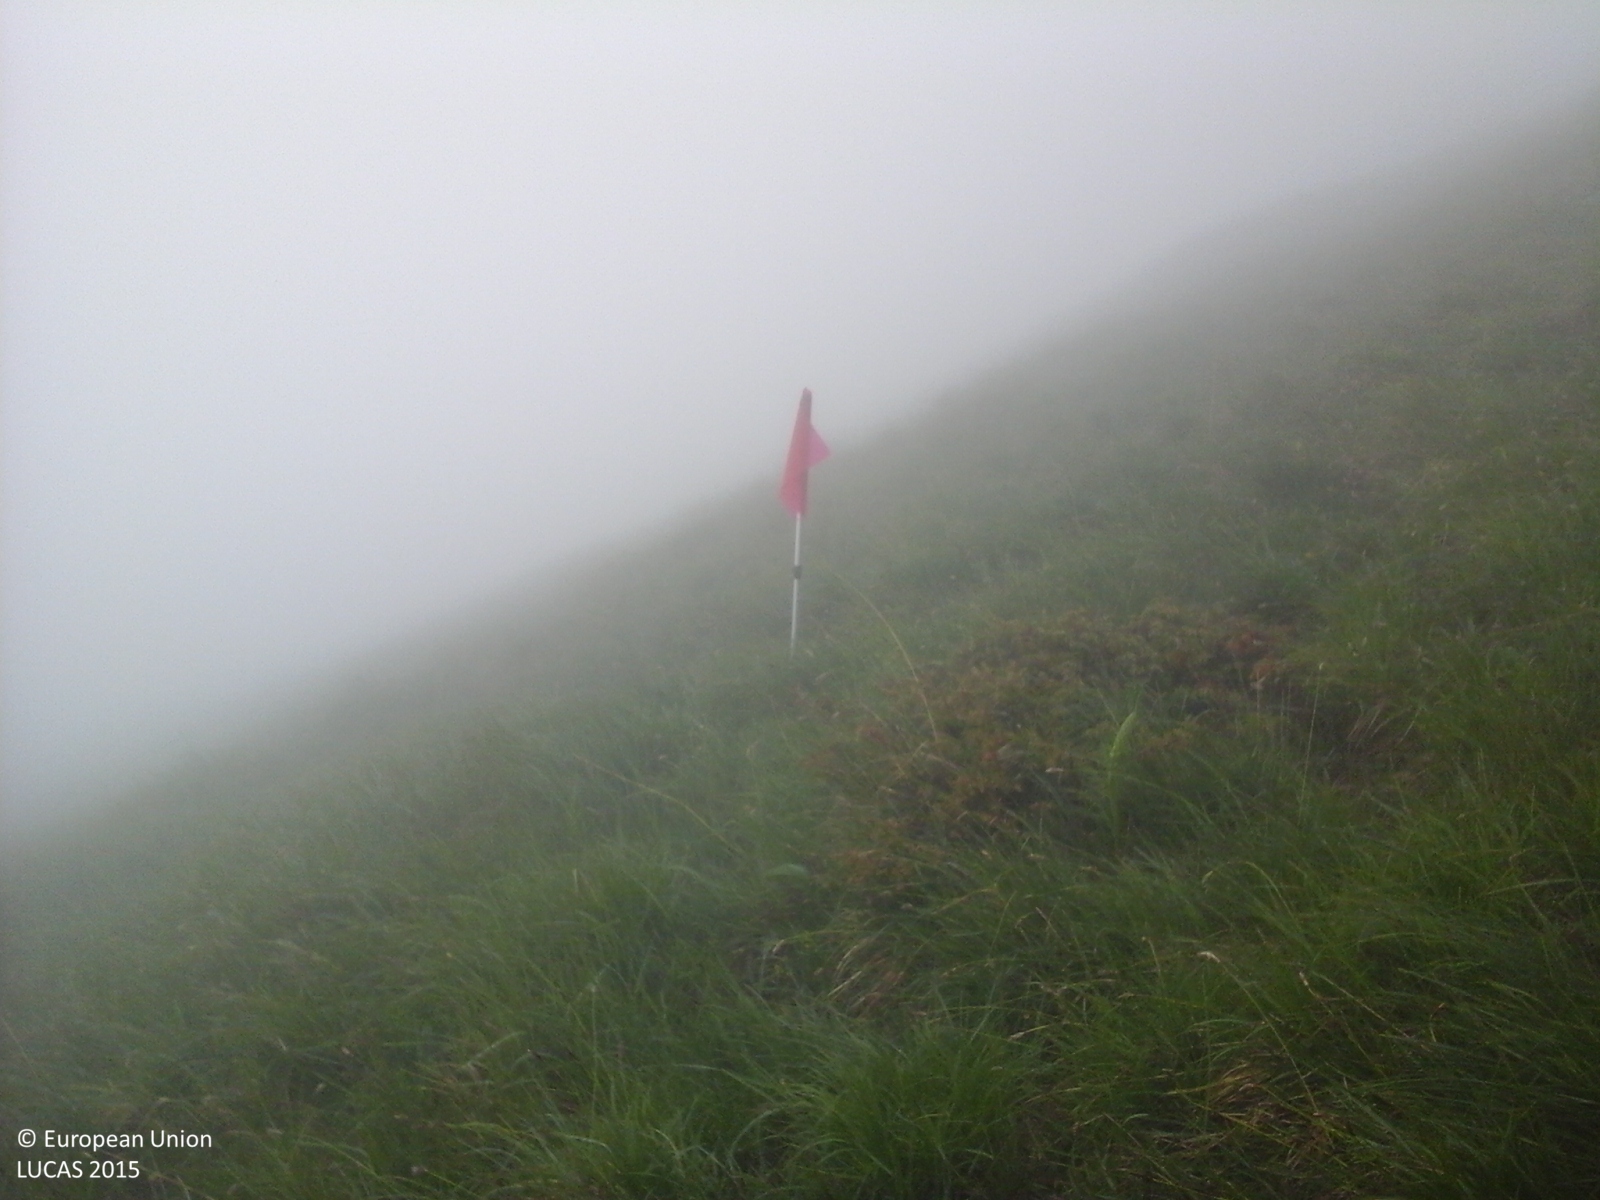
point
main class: Grassland
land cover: Grassland without tree/shrub cover
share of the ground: > 75 %
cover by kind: herbaceous plants 100 %
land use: Agriculture (excluding fallow land and kitchen gardens)
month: May
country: IT
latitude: 45.7712
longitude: 10.8602
